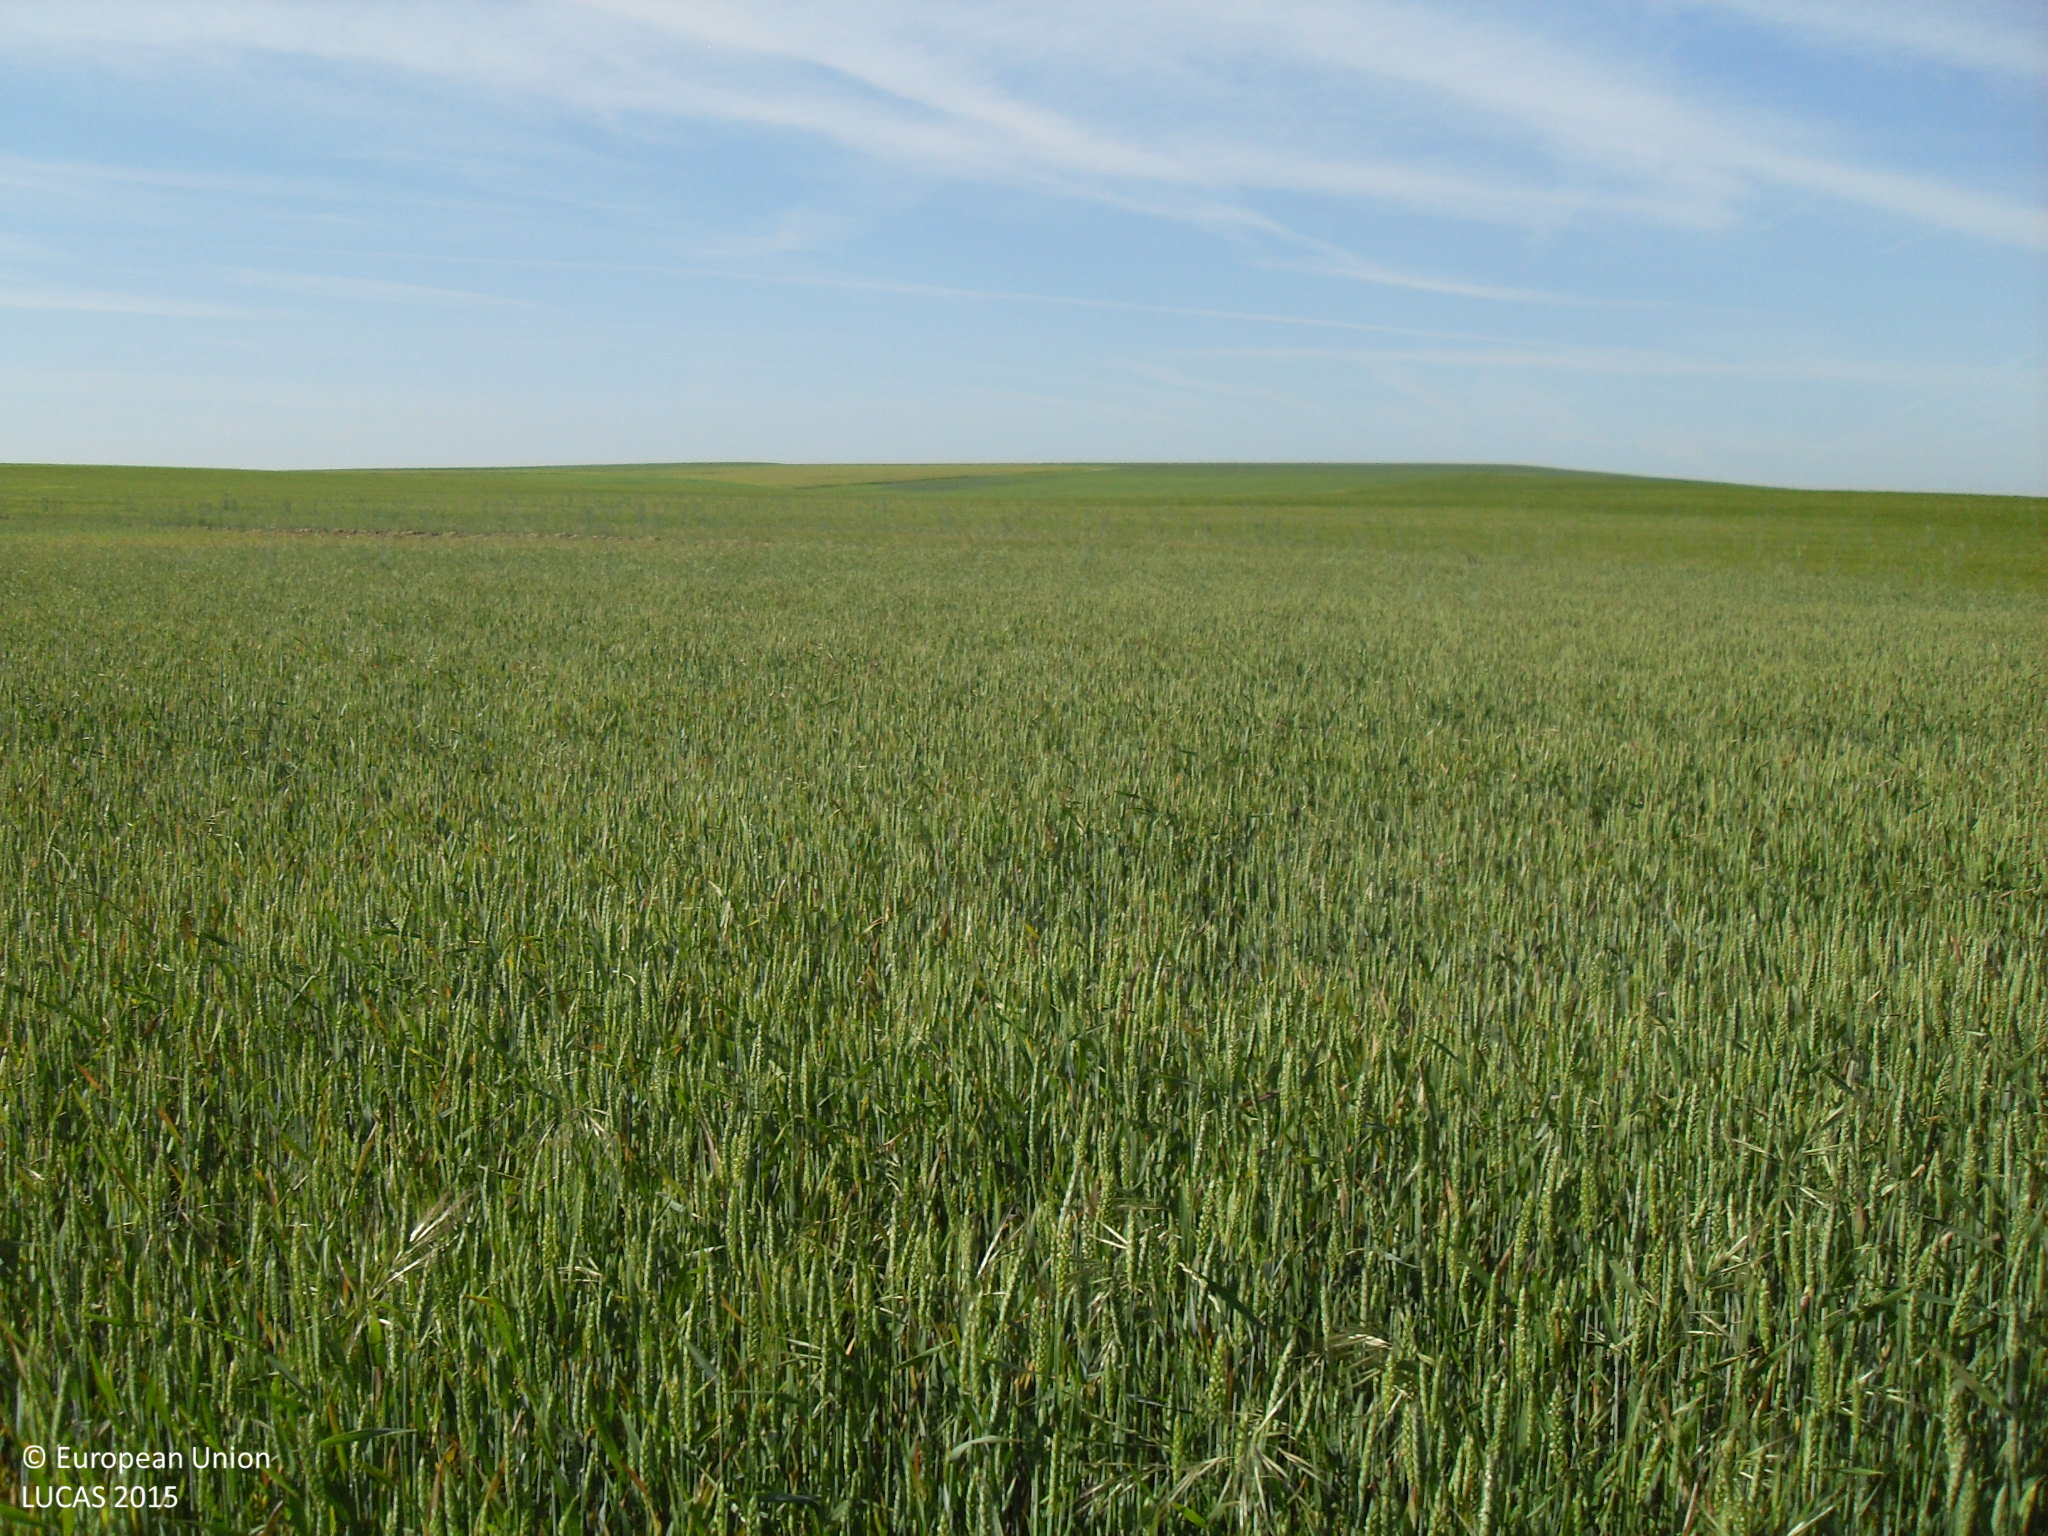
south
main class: Cropland
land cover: Common wheat
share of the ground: > 75 %
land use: Agriculture (excluding fallow land and kitchen gardens)
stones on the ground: 25 - 50 %
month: May
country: ES
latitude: 40.9069
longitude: -5.3494
